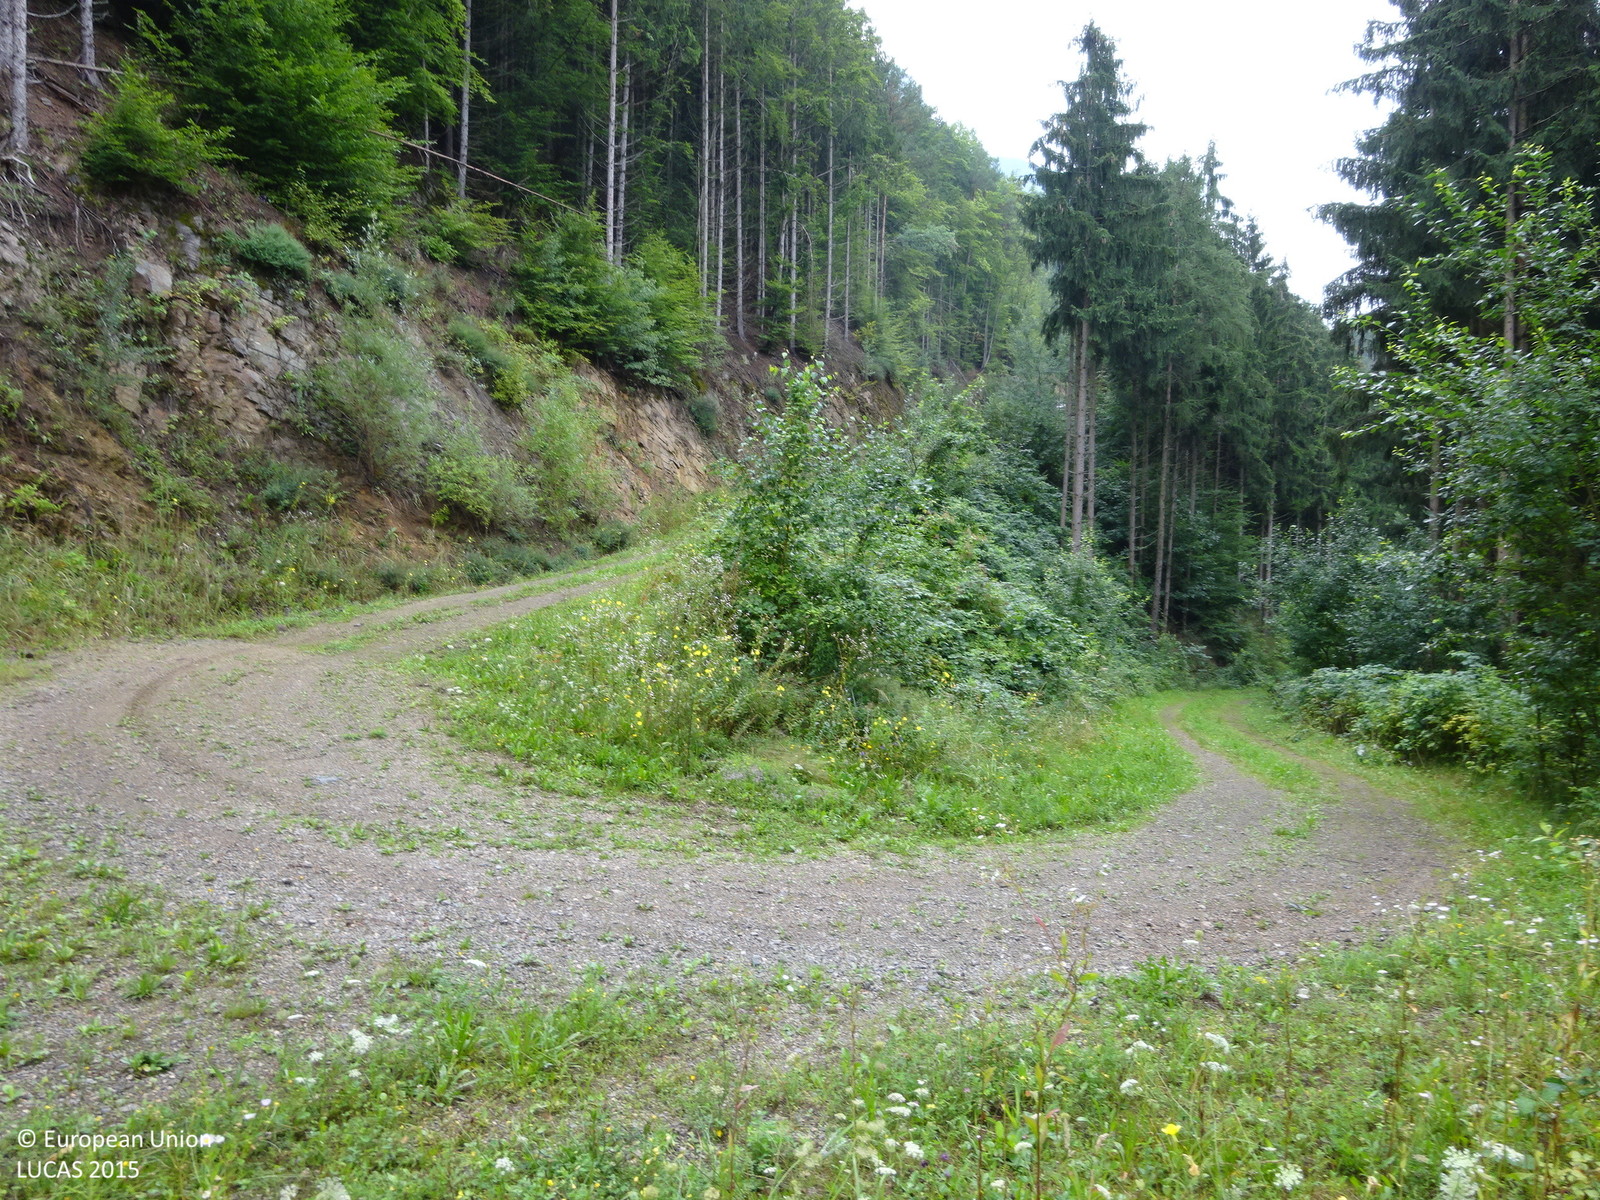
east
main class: Grassland
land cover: Spontaneously vegetated surfaces
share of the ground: > 75 %
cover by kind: herbaceous plants 100 %
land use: Forestry
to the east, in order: Spontaneously vegetated surfaces; Tracks; Spruce dominated coniferous woodland; Spruce dominated mixed woodland; Tracks; Spruce dominated coniferous woodland; Spruce dominated mixed woodland; Tracks; Spruce dominated mixed woodland
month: July
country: AT
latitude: 47.3356
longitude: 15.3601
